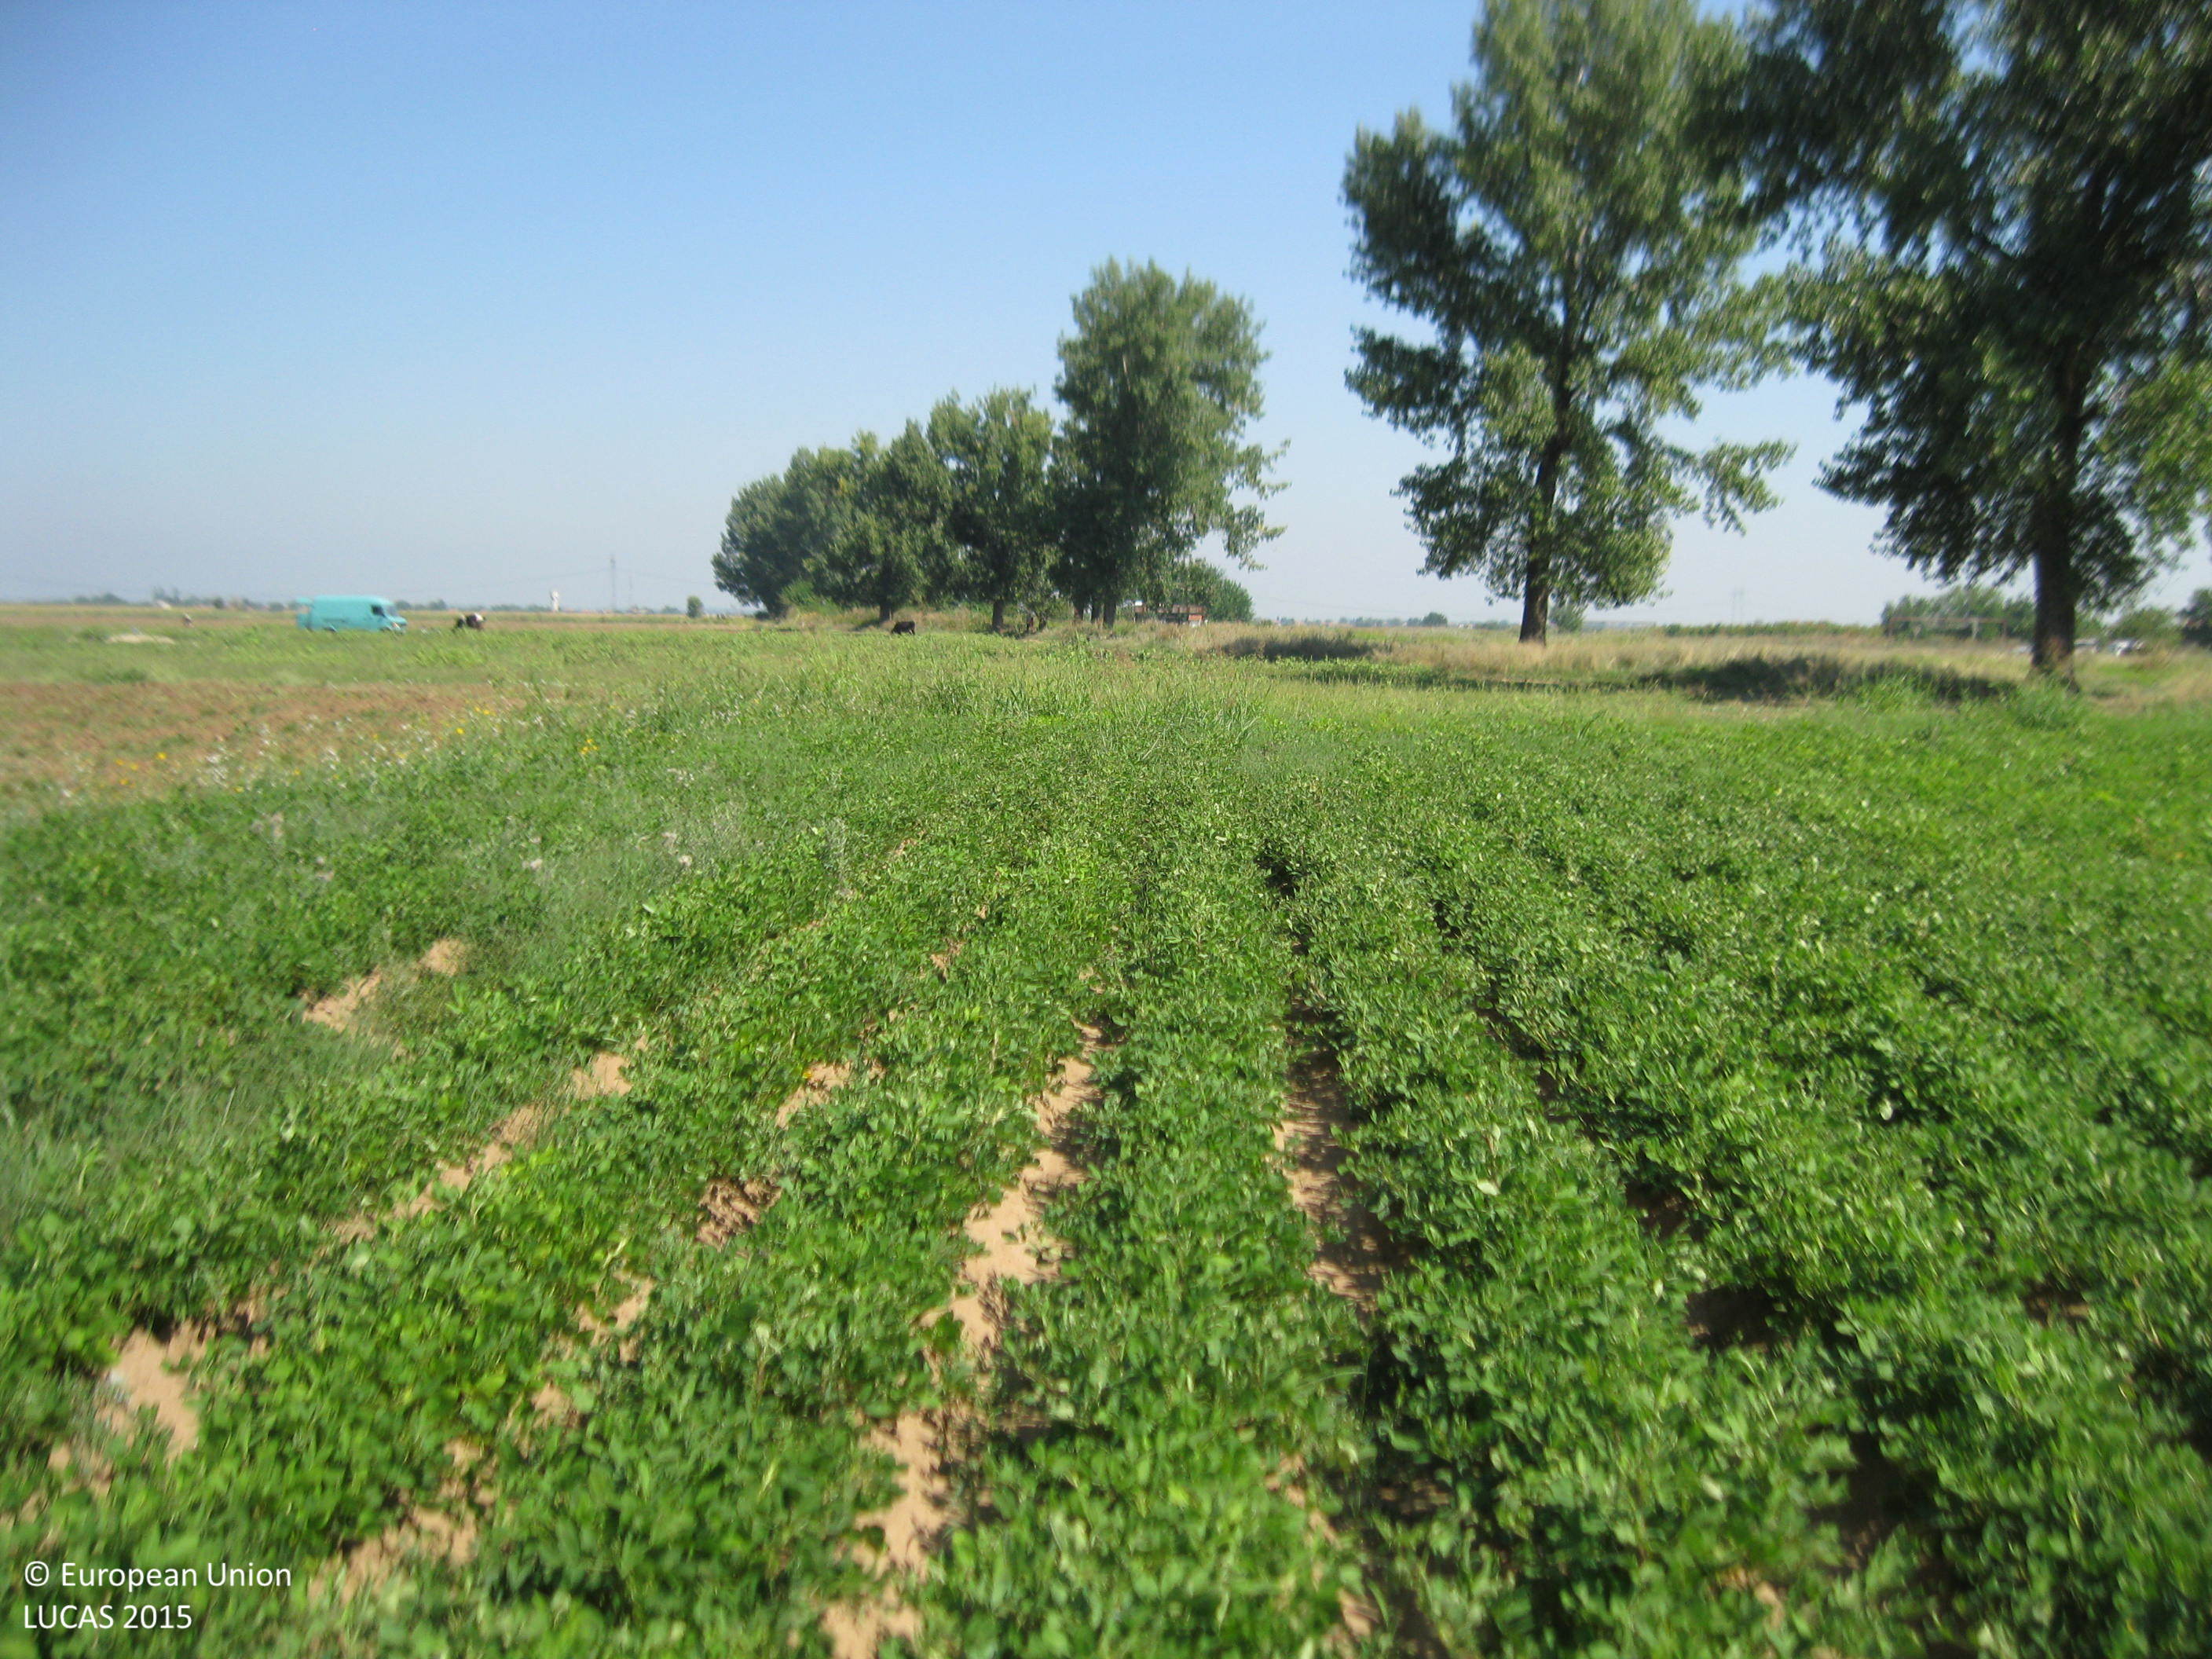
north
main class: Cropland
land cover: Soya
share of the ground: > 75 %
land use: Agriculture (excluding fallow land and kitchen gardens)
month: September
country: BG
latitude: 42.0752
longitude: 24.9085
